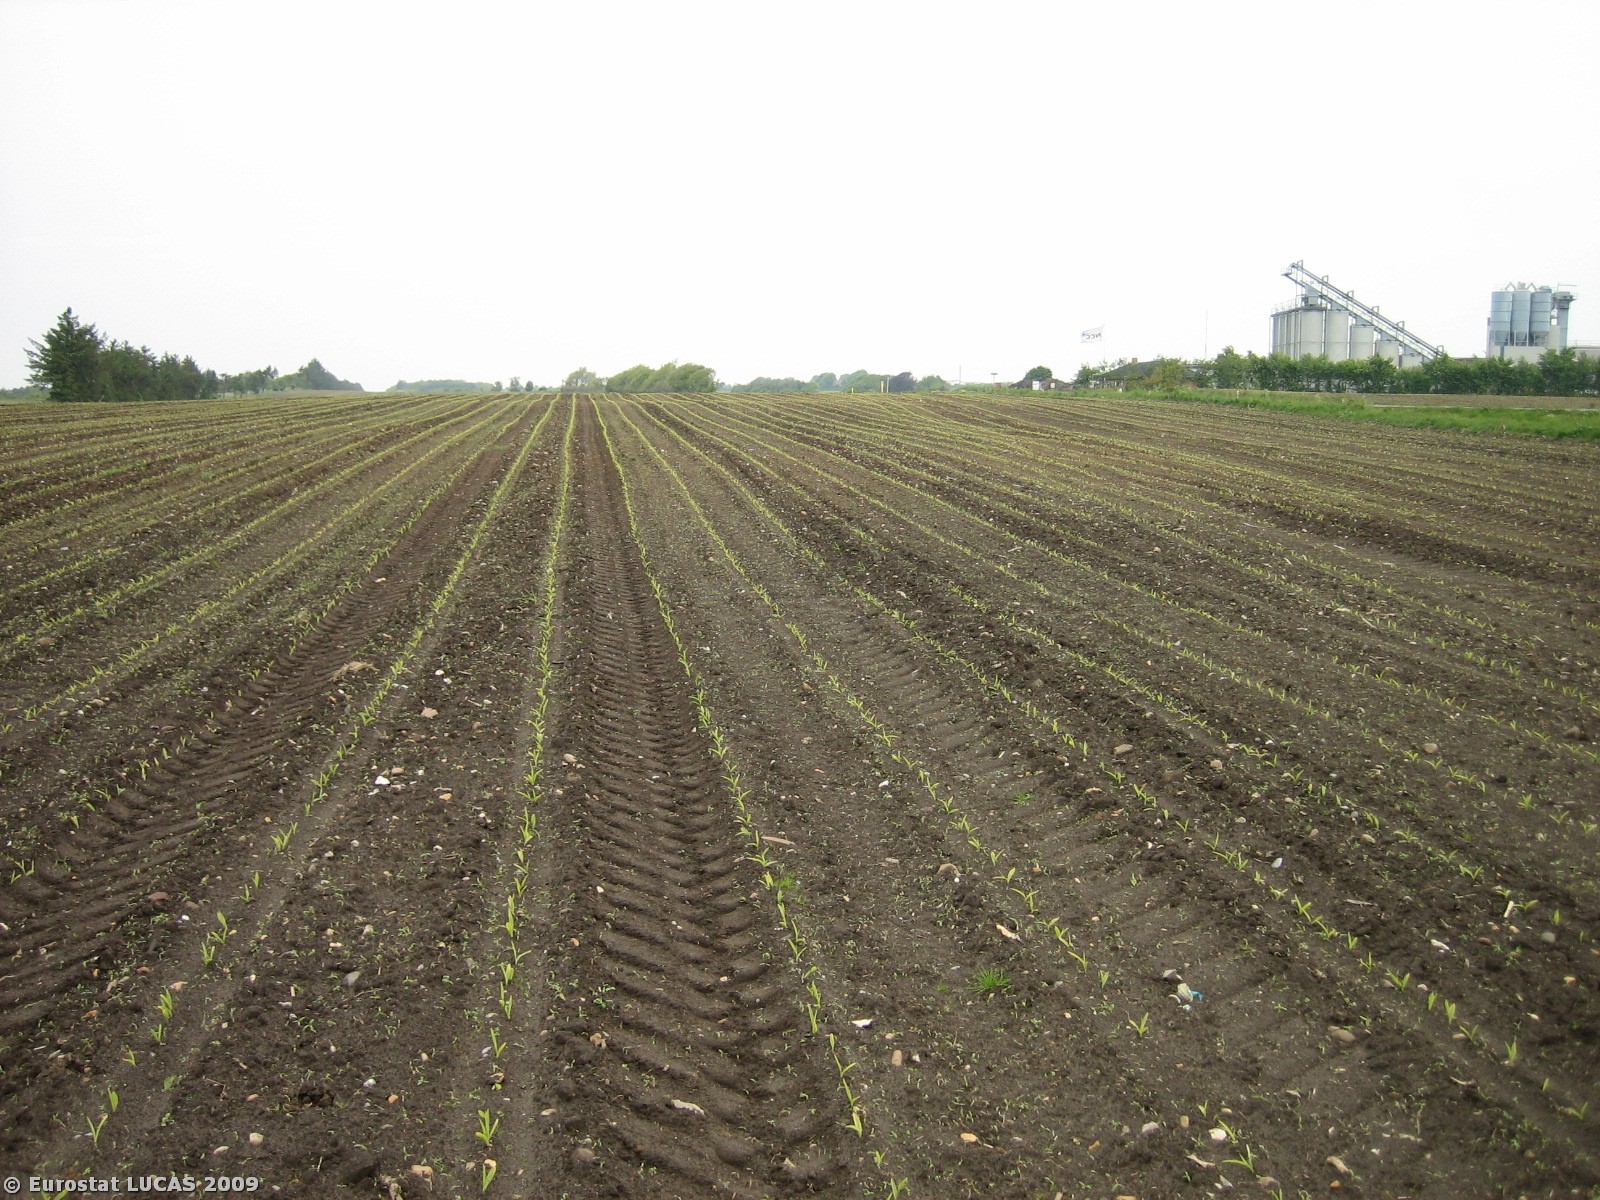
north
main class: Cropland
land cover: Maize
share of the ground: < 10 %
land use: Agriculture (excluding fallow land and kitchen gardens)
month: May
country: DK
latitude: 56.0892
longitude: 8.5069
